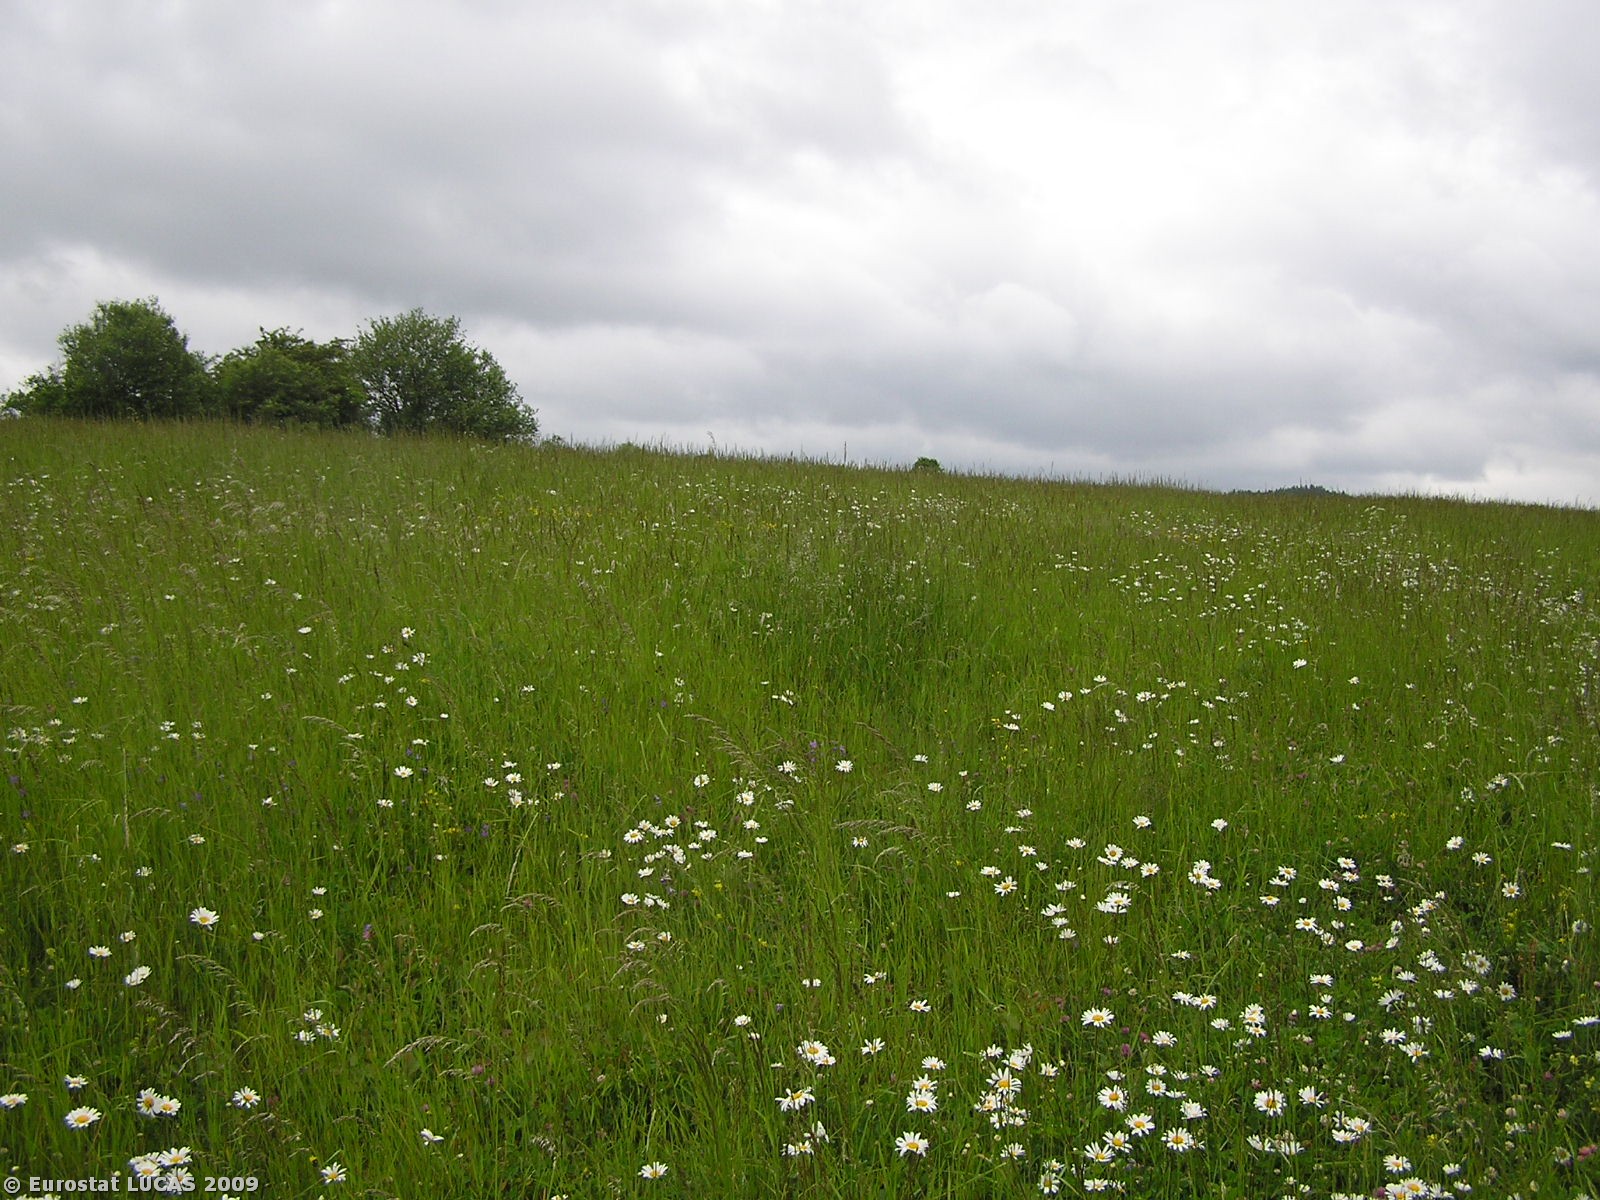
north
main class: Grassland
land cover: Grassland without tree/shrub cover
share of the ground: > 75 %
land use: Agriculture (excluding fallow land and kitchen gardens)
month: June
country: CZ
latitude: 50.0502
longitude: 17.4278
